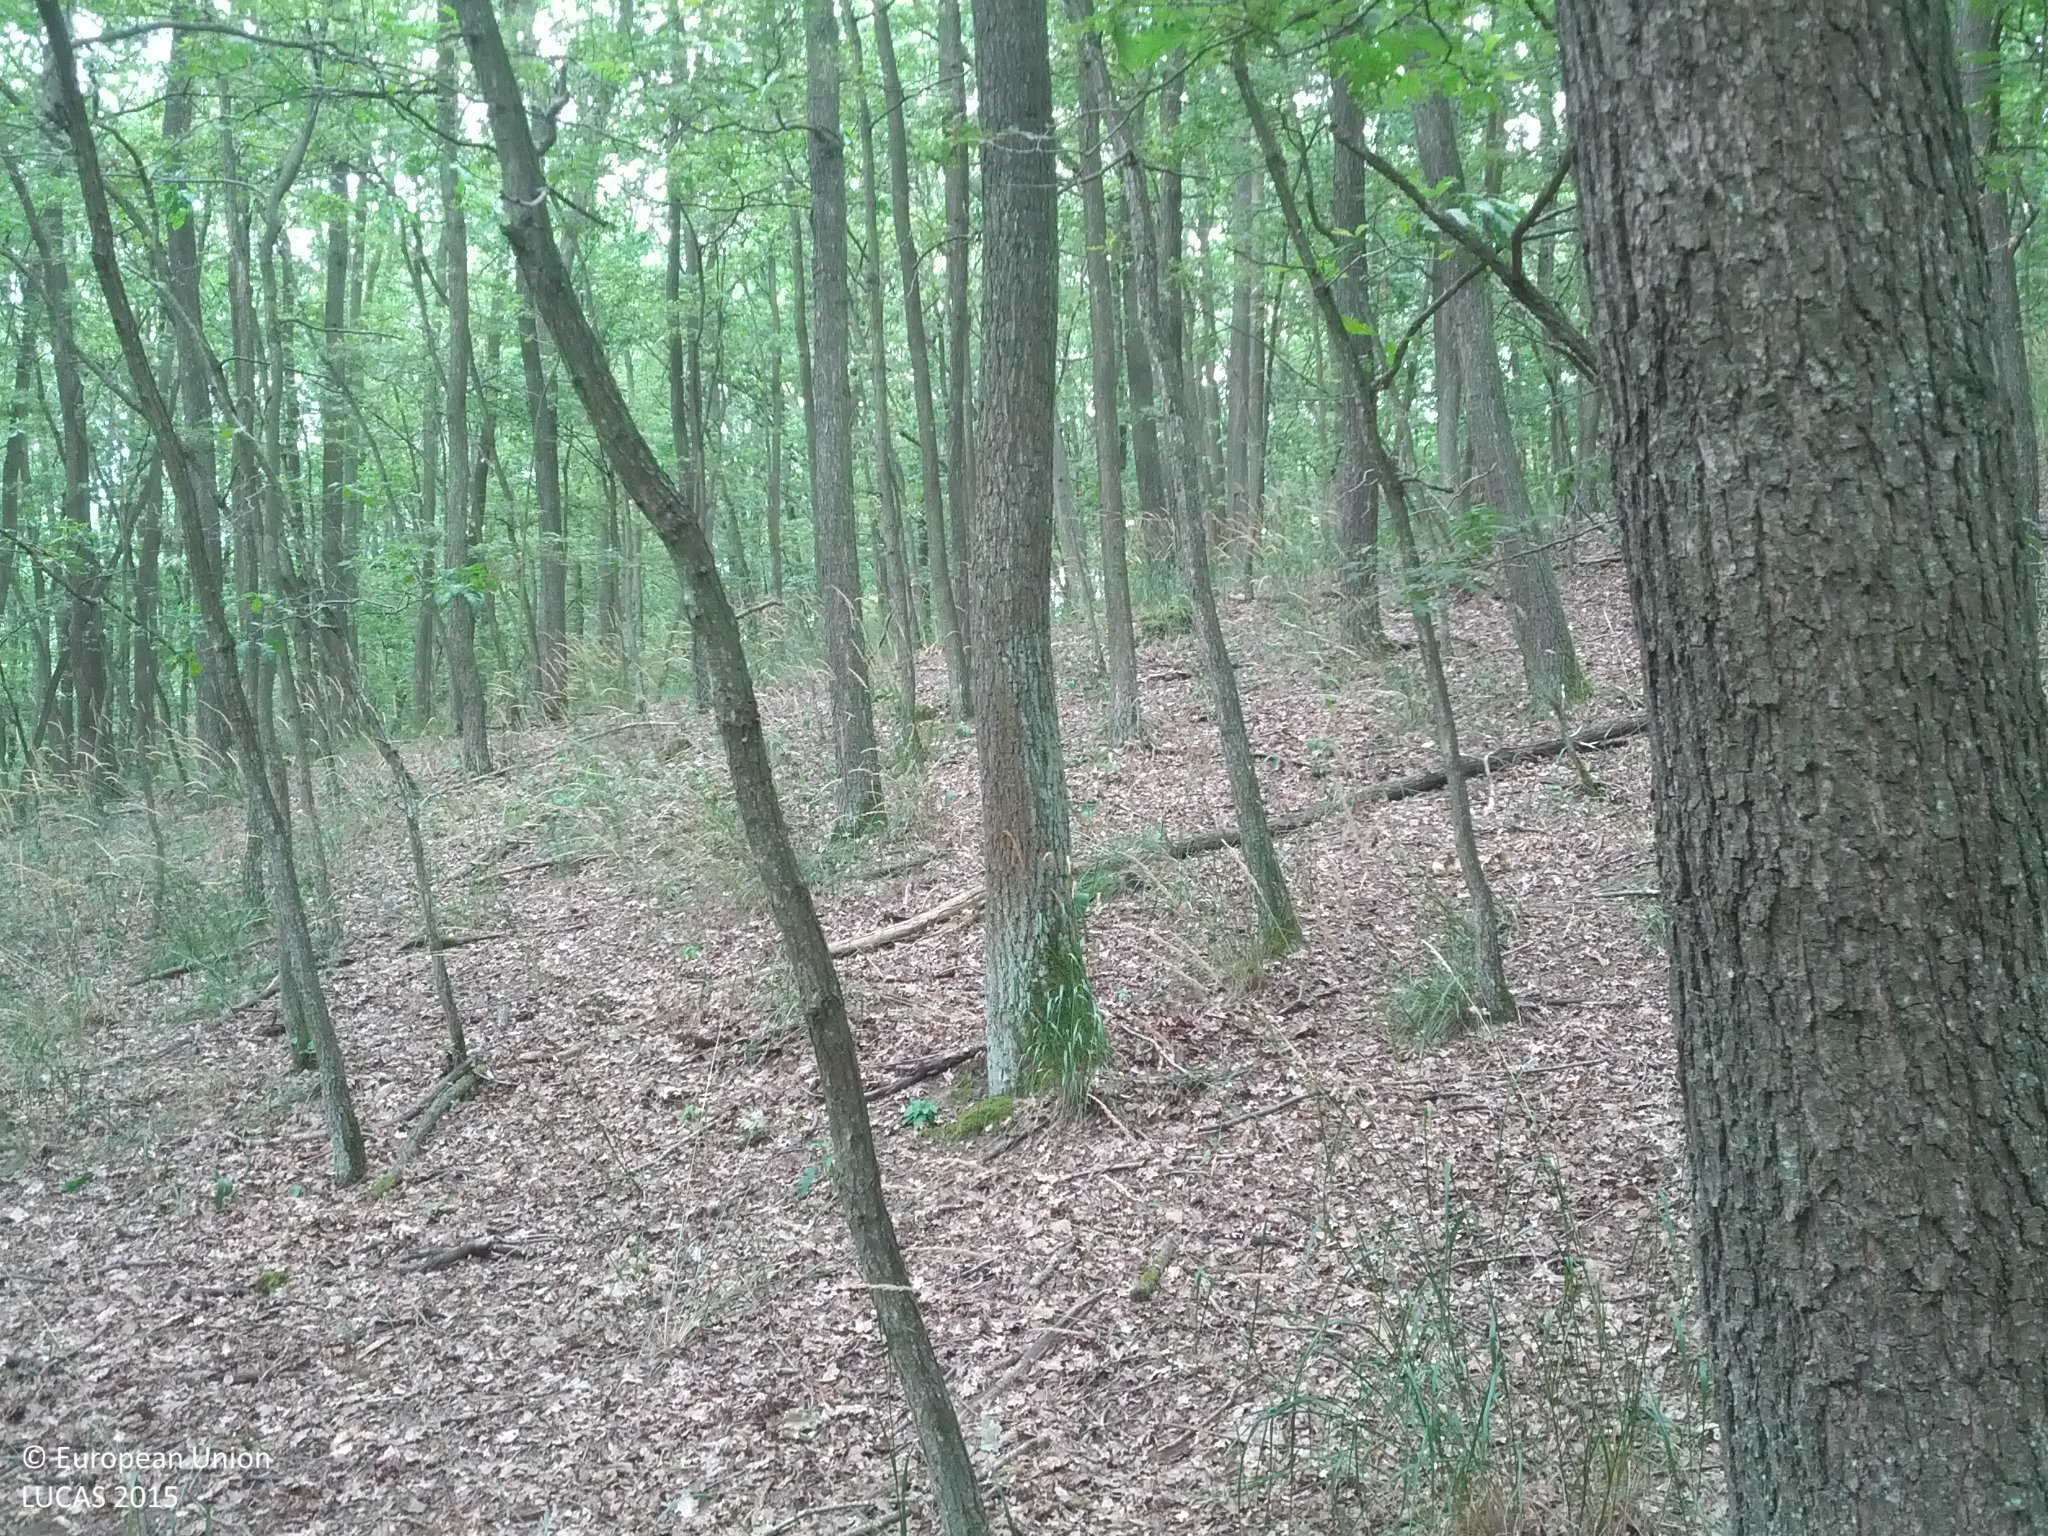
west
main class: Woodland
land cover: Broadleaved woodland
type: acidophilous oak and oak-birch forest
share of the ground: > 75 %
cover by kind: broadleaved forest trees 90 %, herbaceous plants 10 %
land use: Forestry
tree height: > 5 m
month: July
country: AT
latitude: 48.5396
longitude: 16.1403
